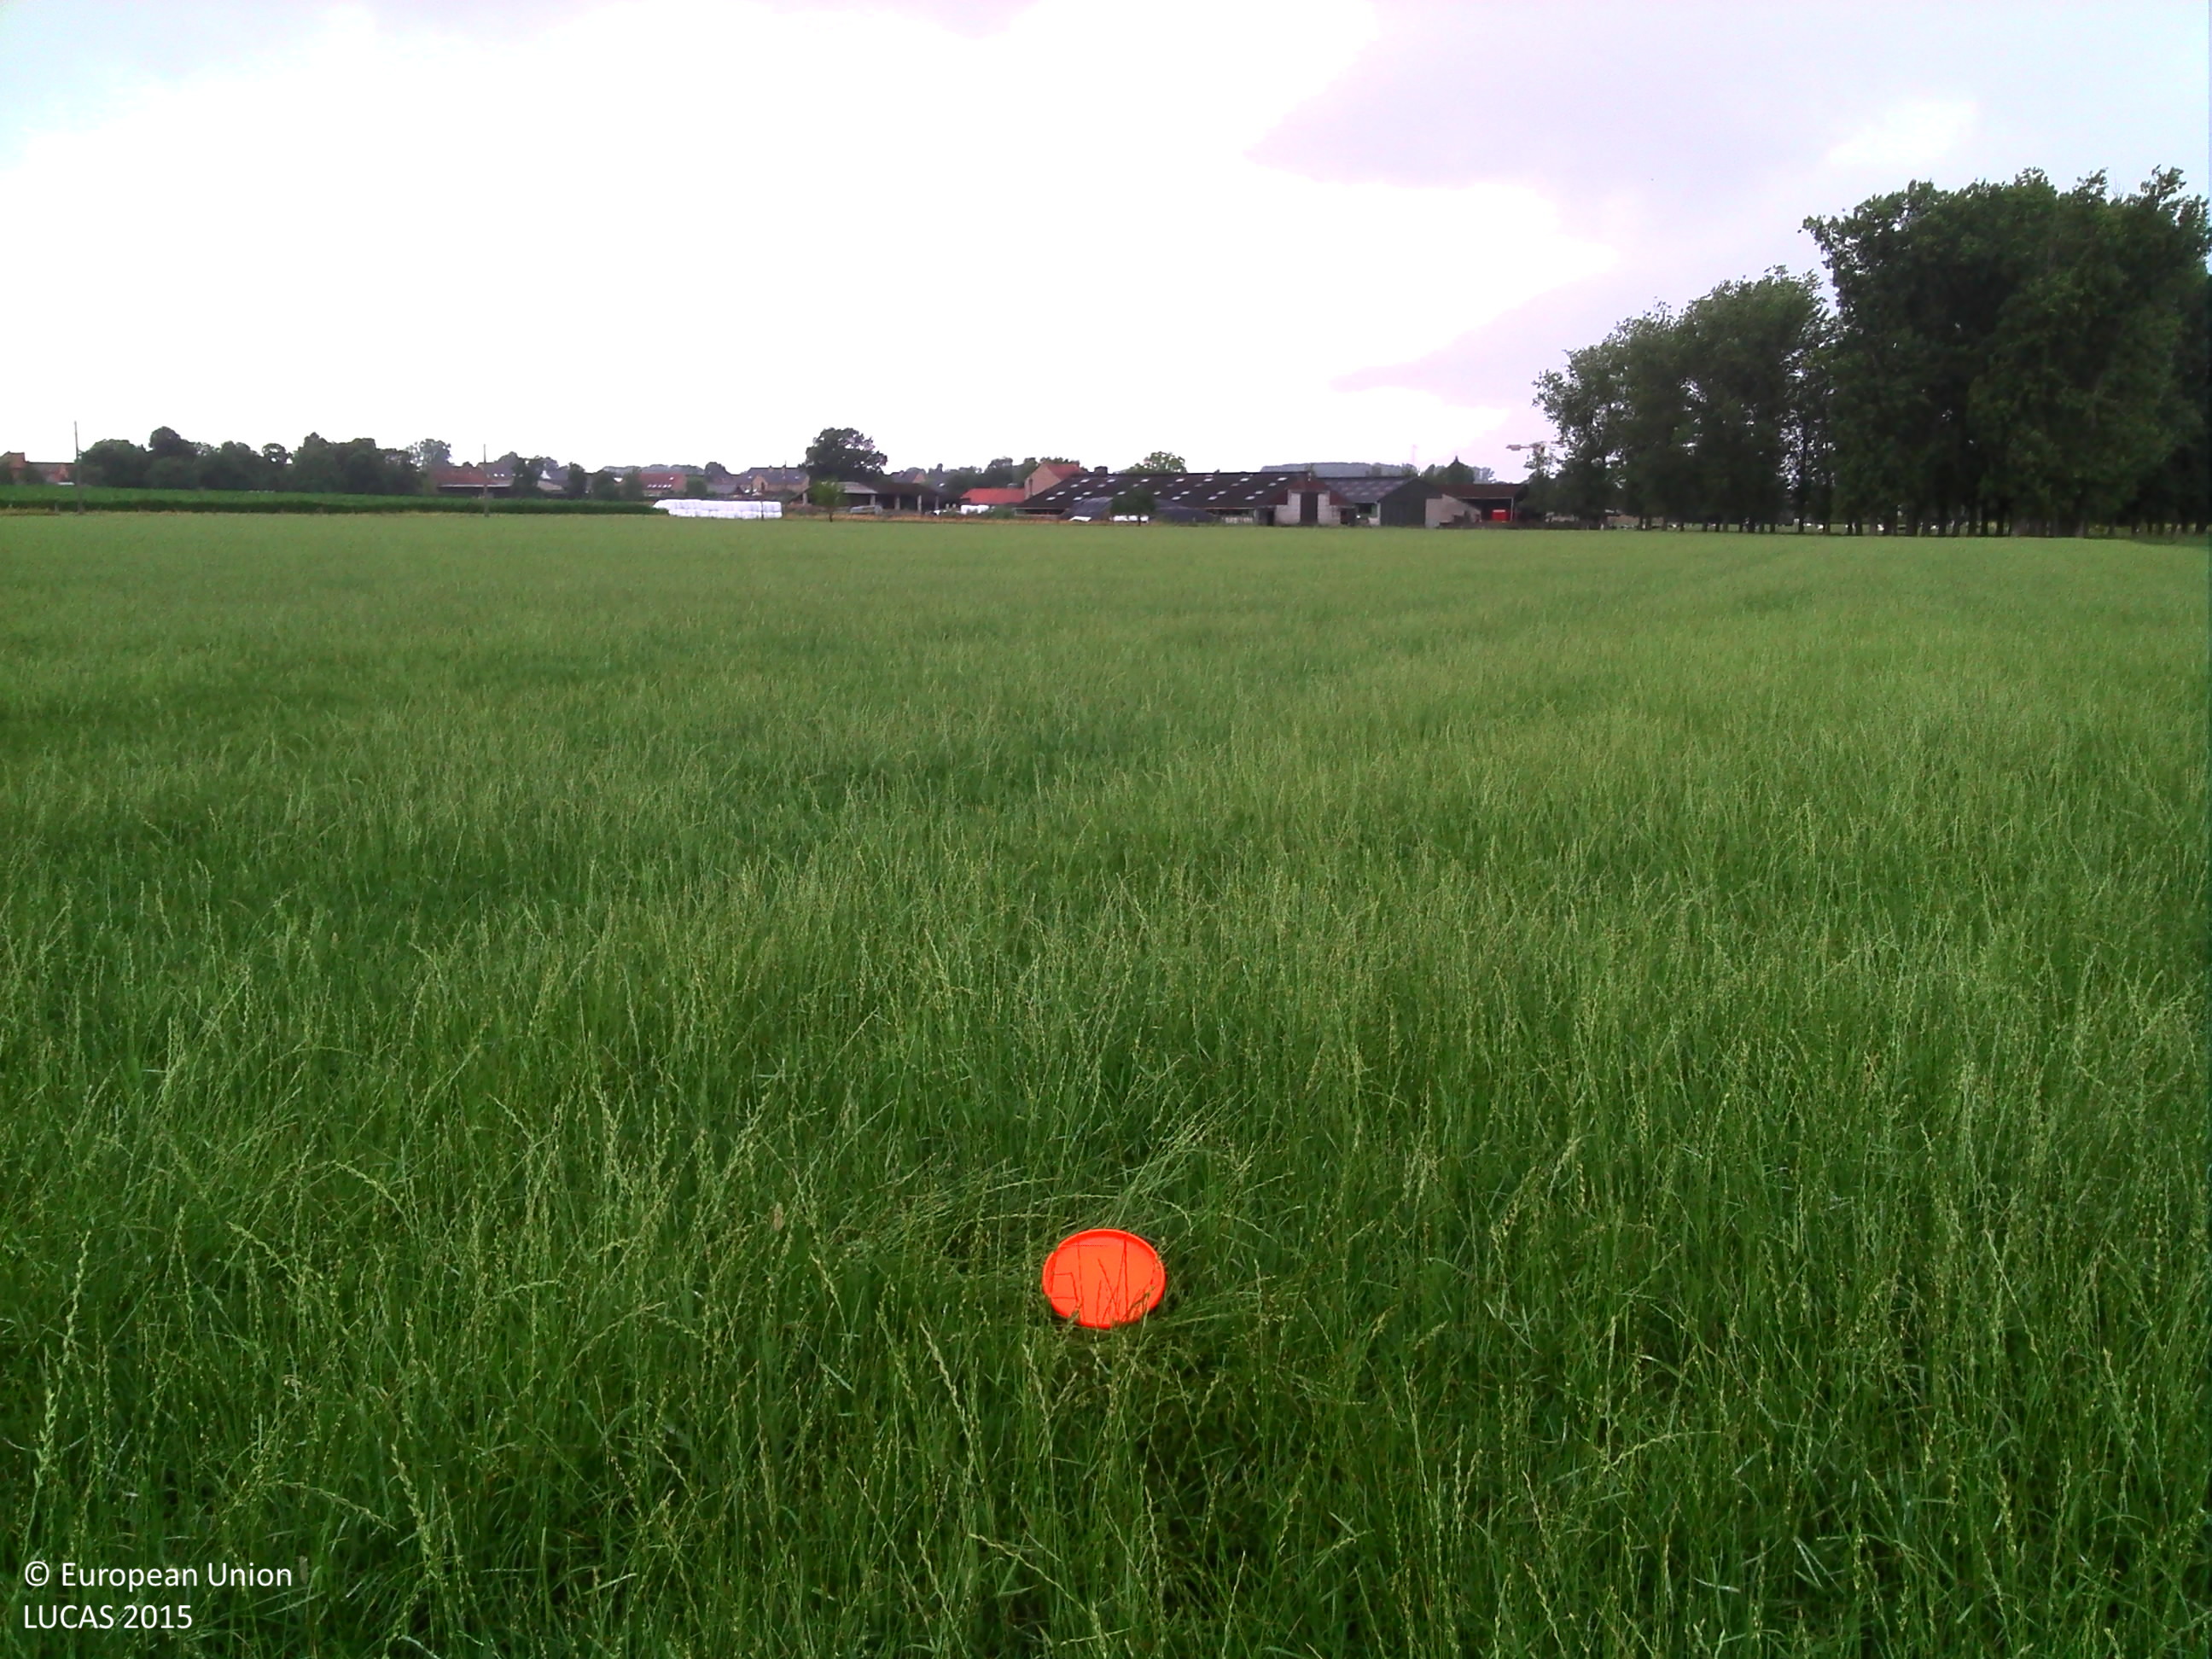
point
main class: Cropland
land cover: Temporary grasslands
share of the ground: > 75 %
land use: Agriculture (excluding fallow land and kitchen gardens)
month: July
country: BE
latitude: 50.8875
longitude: 5.4919
